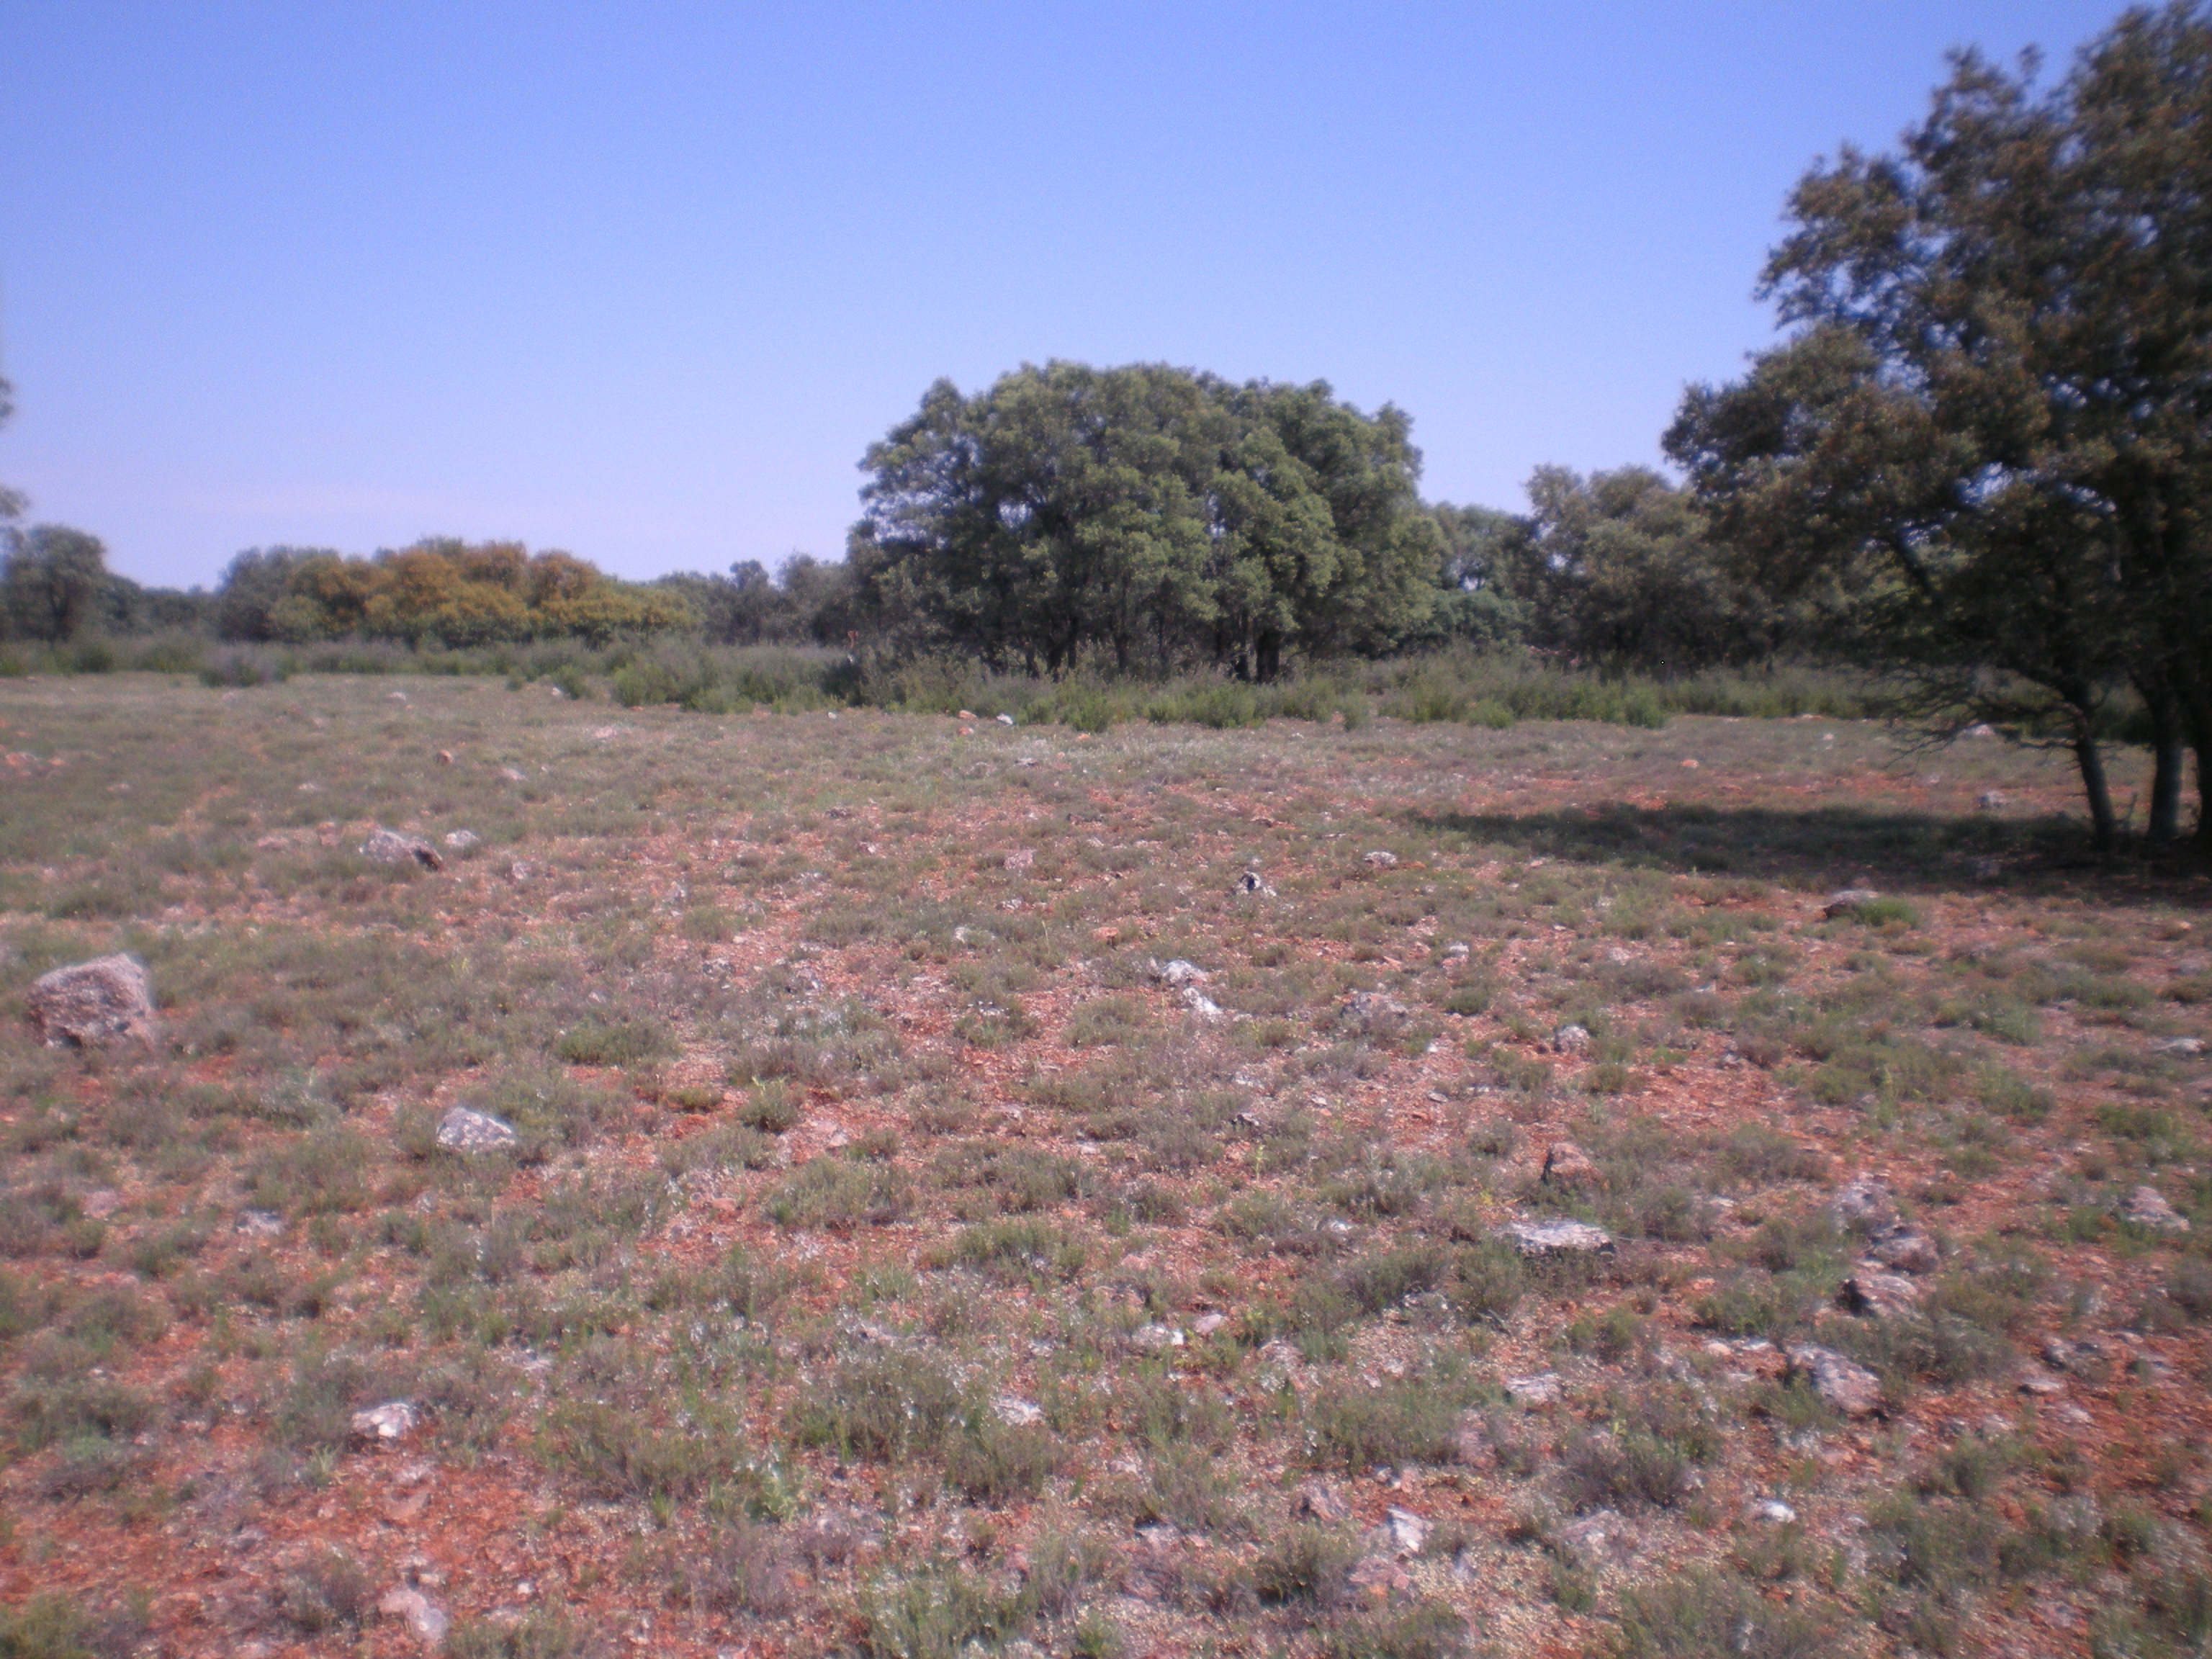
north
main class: Woodland
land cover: Broadleaved woodland
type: broadleaved evergreen forest
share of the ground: 25 - 50 %
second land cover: Shrubland without tree cover
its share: 25 - 50 %
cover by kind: unconsolidated bare surface 40 %, shrubs 35 %, broadleaved forest trees 15 %, herbaceous plants 10 %
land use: Forestry
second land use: Agriculture (excluding fallow land and kitchen gardens)
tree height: < 5 m
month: May
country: ES
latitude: 38.9126
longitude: -2.9365
